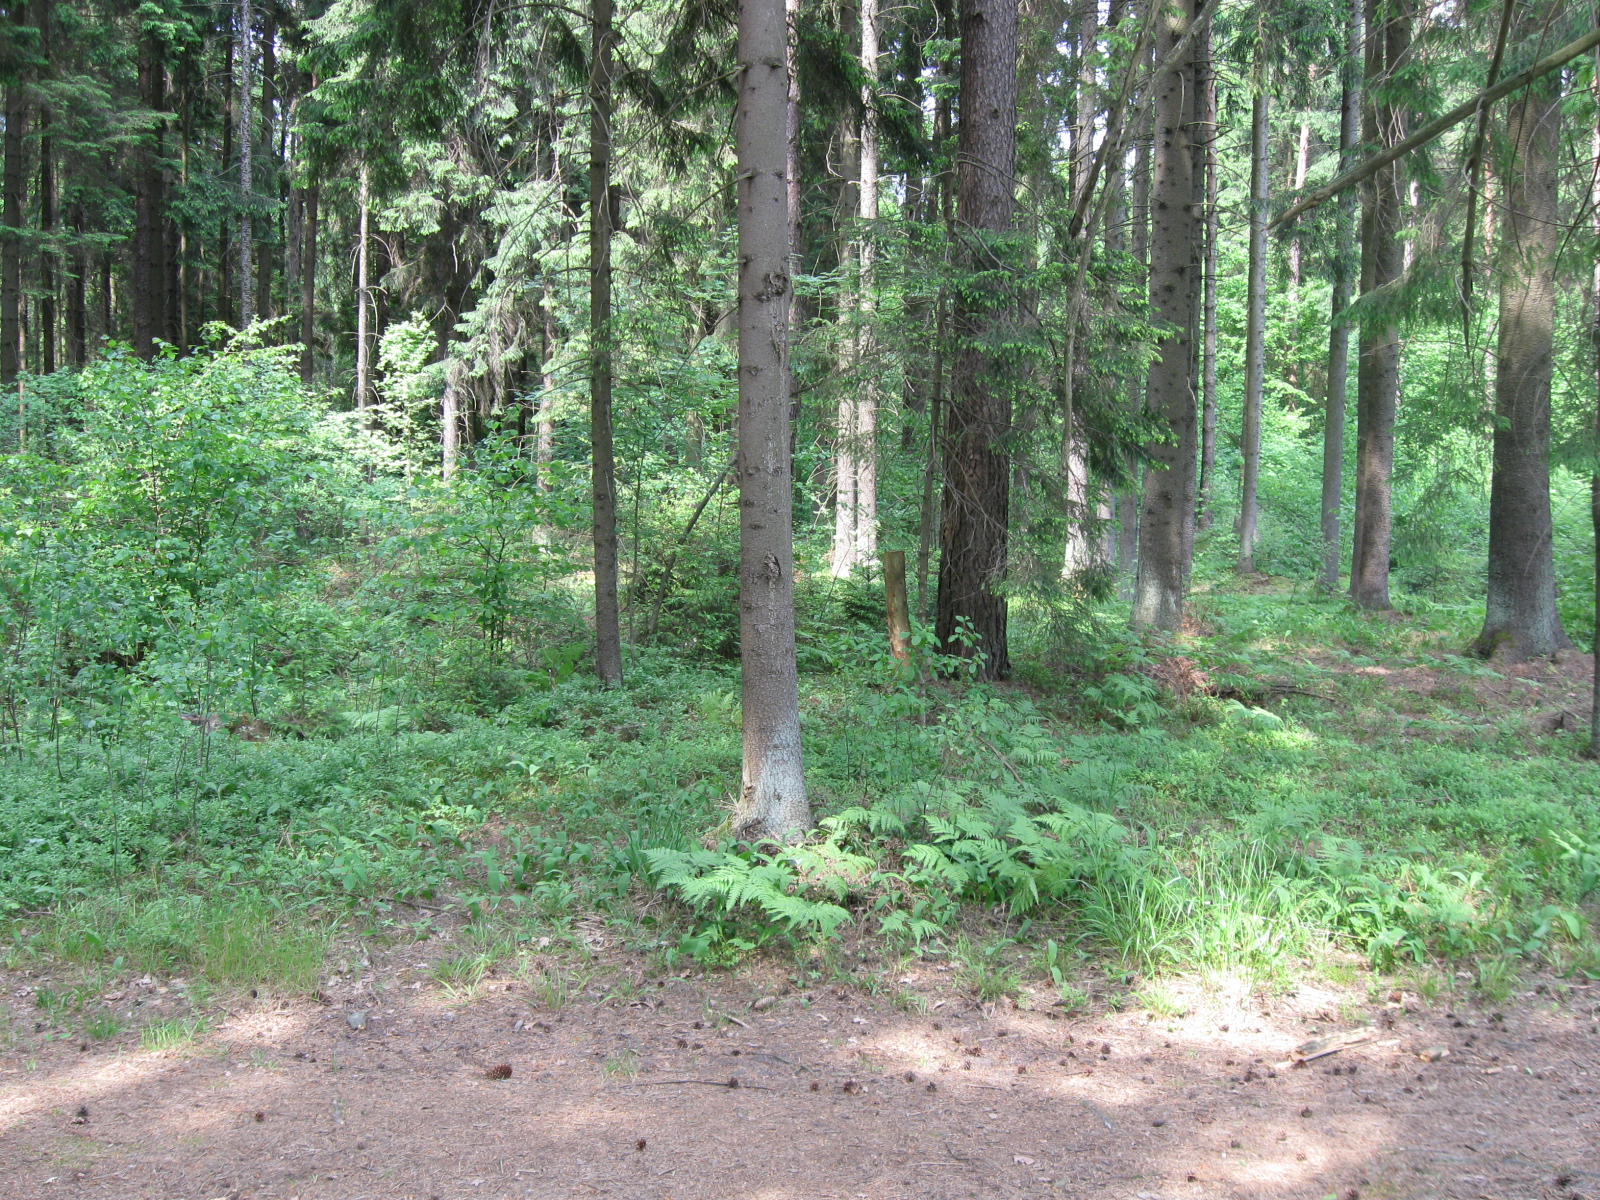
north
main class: Woodland
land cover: Spruce dominated coniferous woodland
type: hemiboreal forest and nemoral coniferous forest and mixed broadleaved-coniferous forest
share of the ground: > 75 %
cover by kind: coniferous forest trees 85 %, herbaceous plants 10 %, unconsolidated bare surface 5 %
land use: Forestry
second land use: Sport
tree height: > 5 m
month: June
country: LT
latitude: 54.9433
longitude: 23.9684
